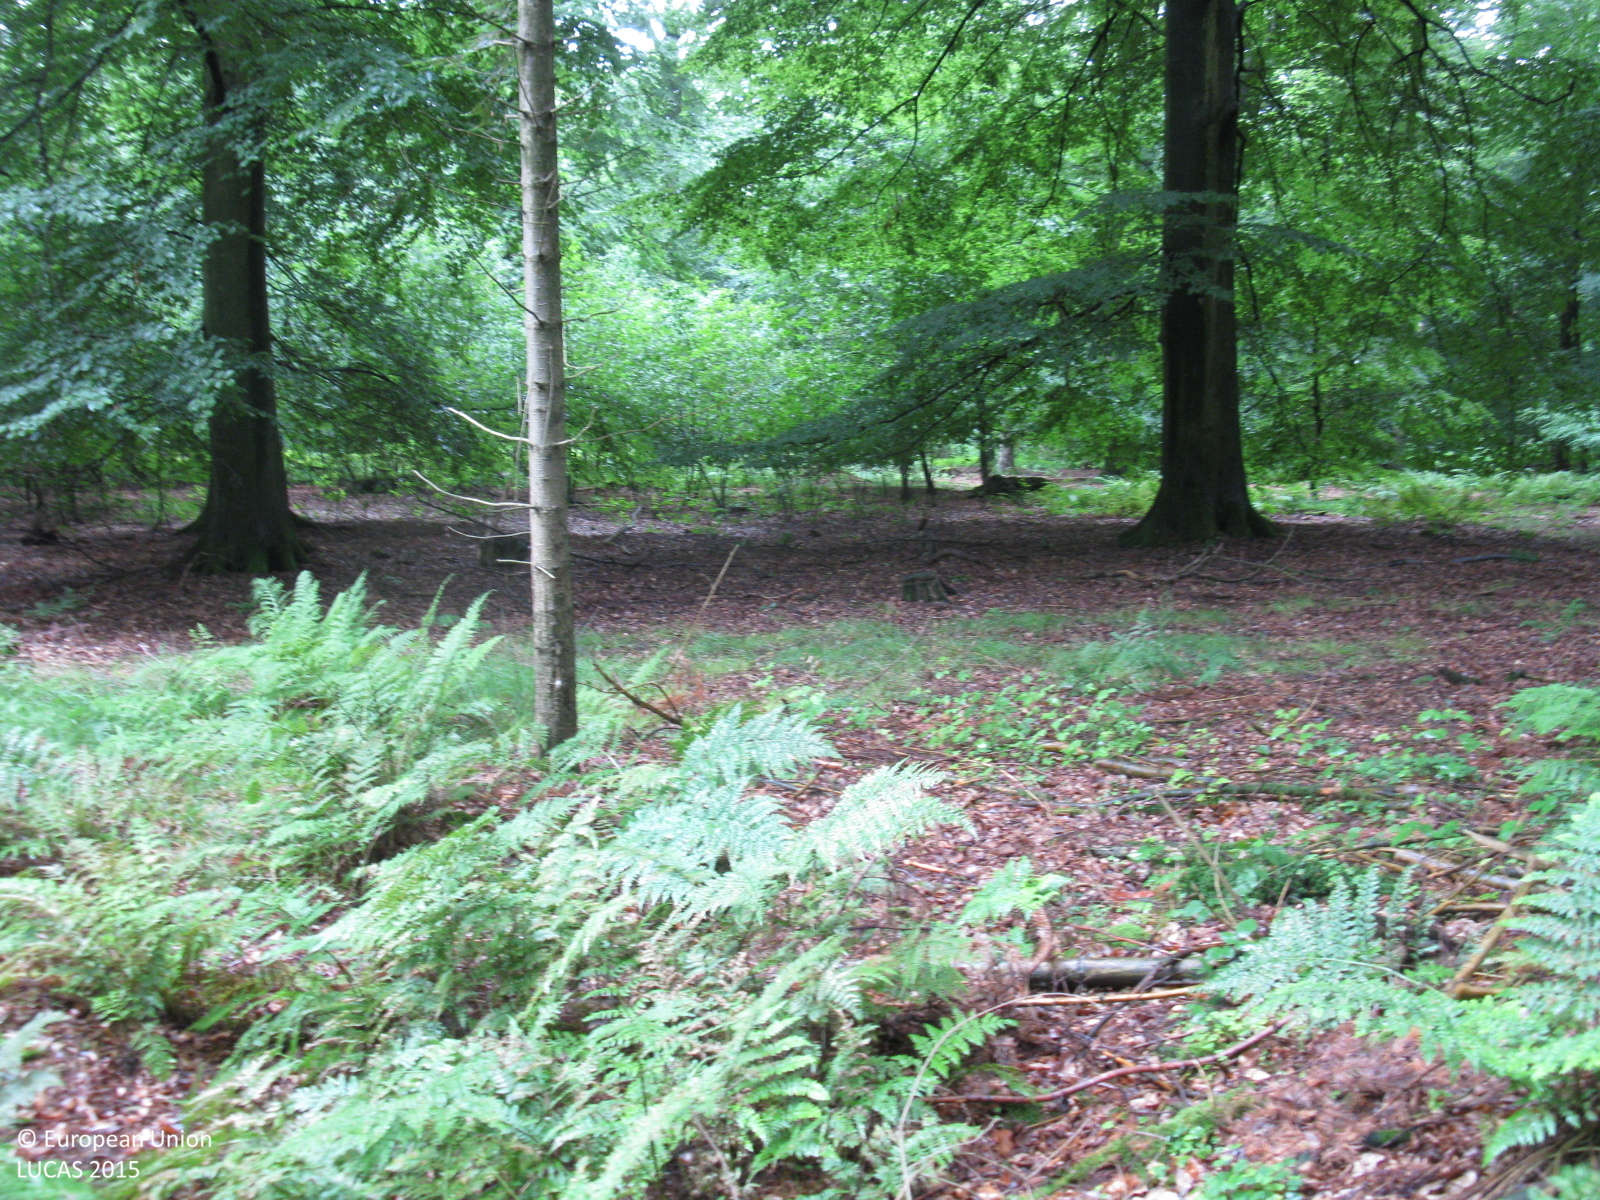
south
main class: Woodland
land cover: Other coniferous woodland
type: hemiboreal forest and nemoral coniferous forest and mixed broadleaved-coniferous forest
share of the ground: > 75 %
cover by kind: coniferous forest trees 100 %
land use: Forestry
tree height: > 5 m
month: July
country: DE
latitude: 52.9263
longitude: 8.5874
